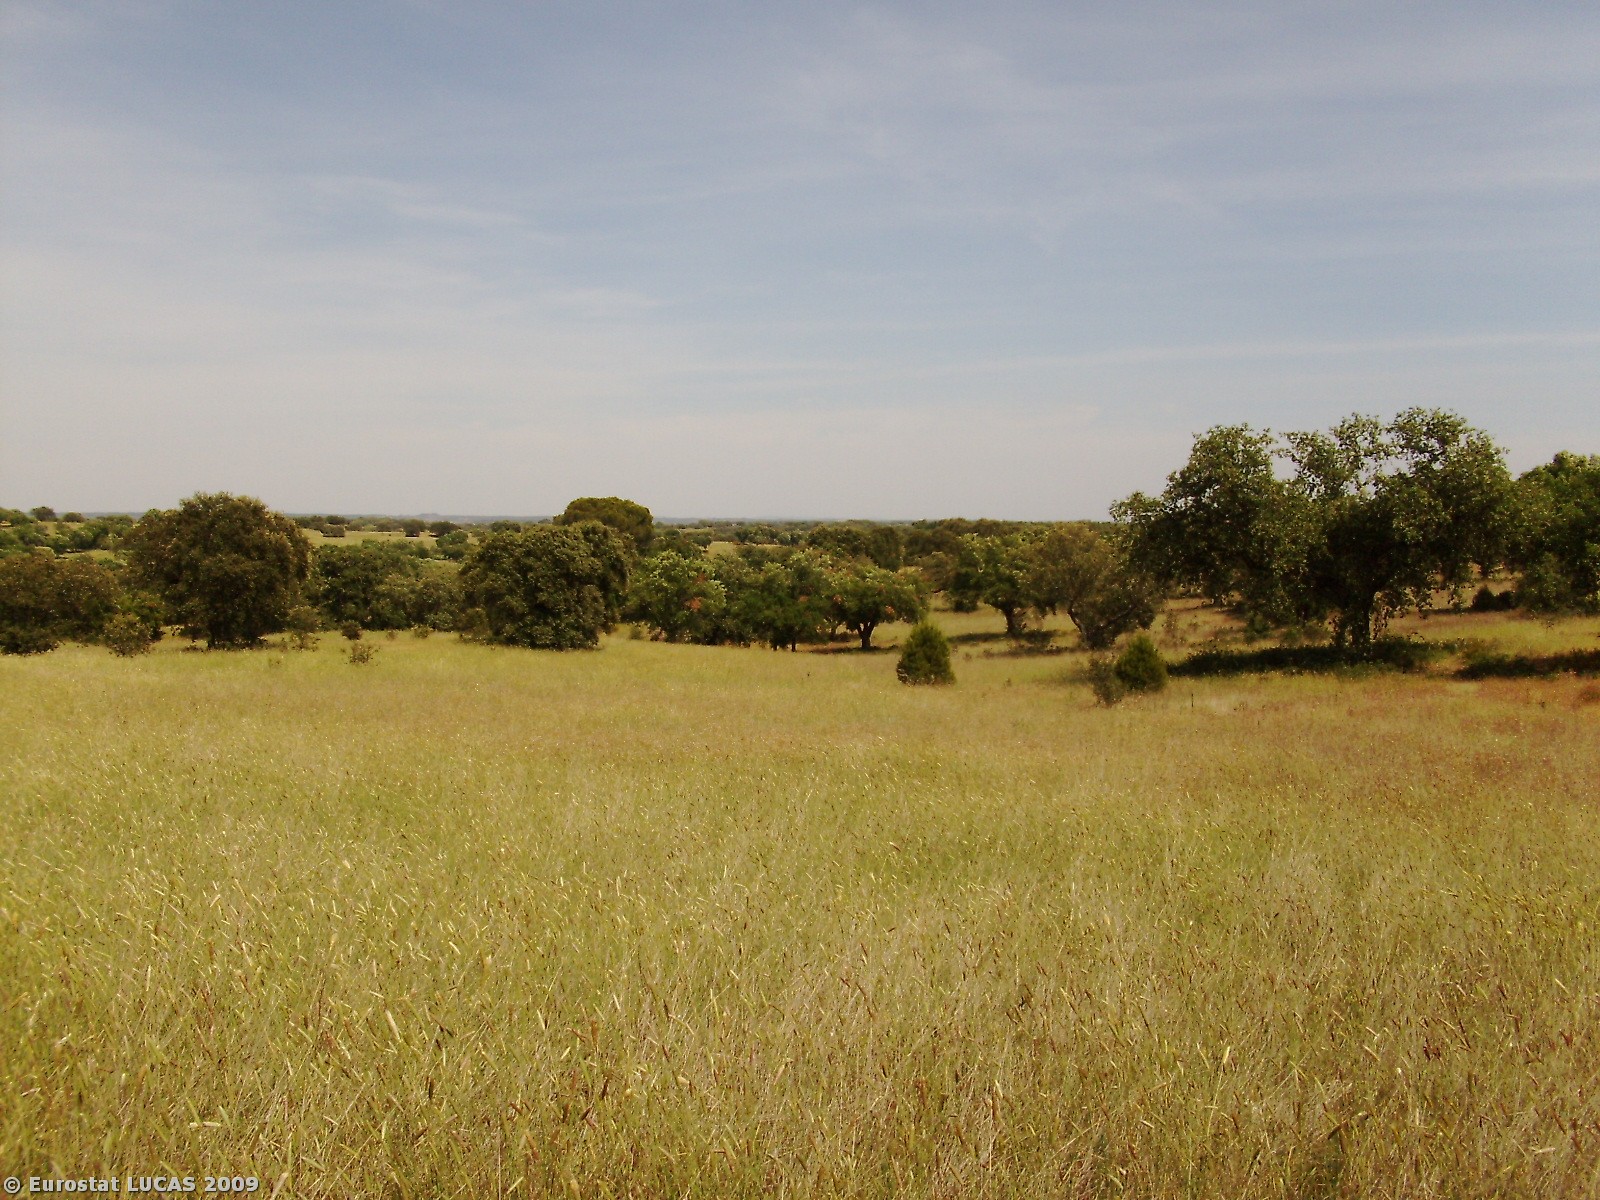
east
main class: Grassland
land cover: Grassland with sparse tree/shrub cover
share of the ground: > 75 %
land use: Agriculture (excluding fallow land and kitchen gardens)
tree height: > 5 m
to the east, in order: Grassland with sparse tree/shrub cover; Broadleaved woodland
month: May
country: PT
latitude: 38.9669
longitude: -8.0433
